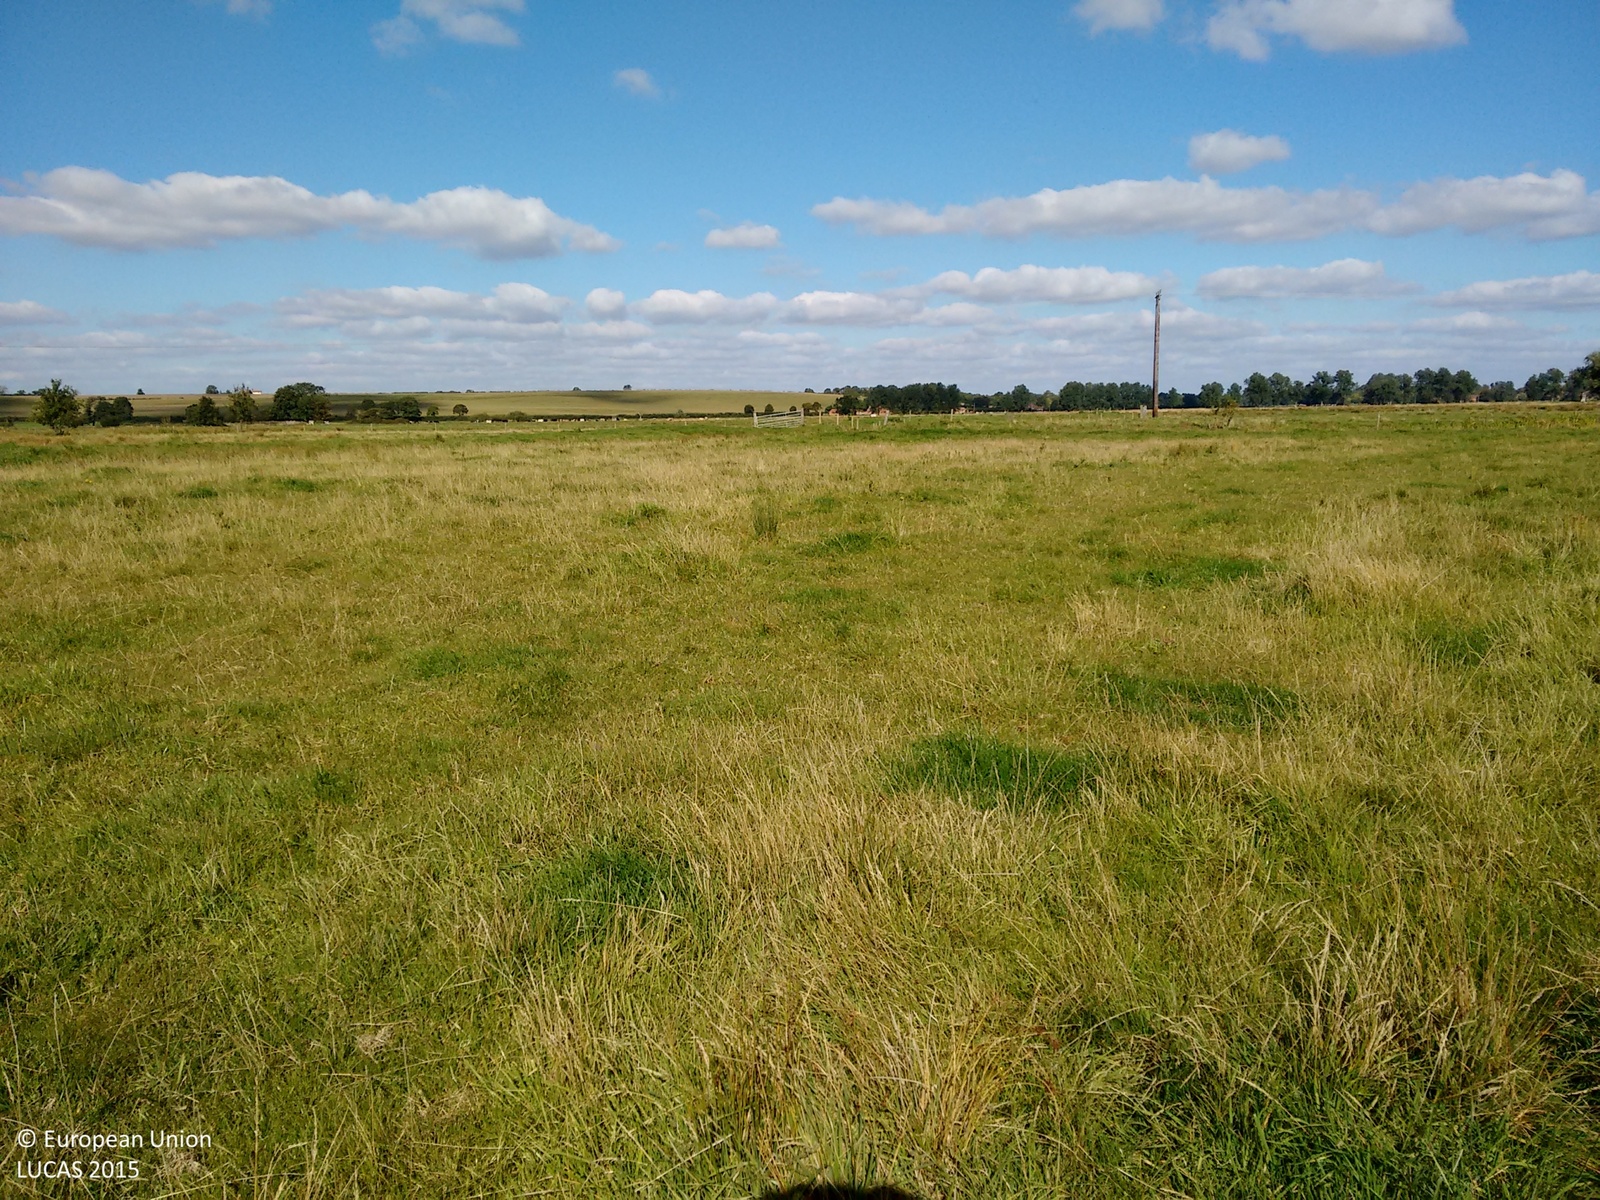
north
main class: Grassland
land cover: Grassland without tree/shrub cover
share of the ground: > 75 %
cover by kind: herbaceous plants 100 %
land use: Agriculture (excluding fallow land and kitchen gardens)
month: October
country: GB
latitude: 52.3850
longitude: 1.3257
